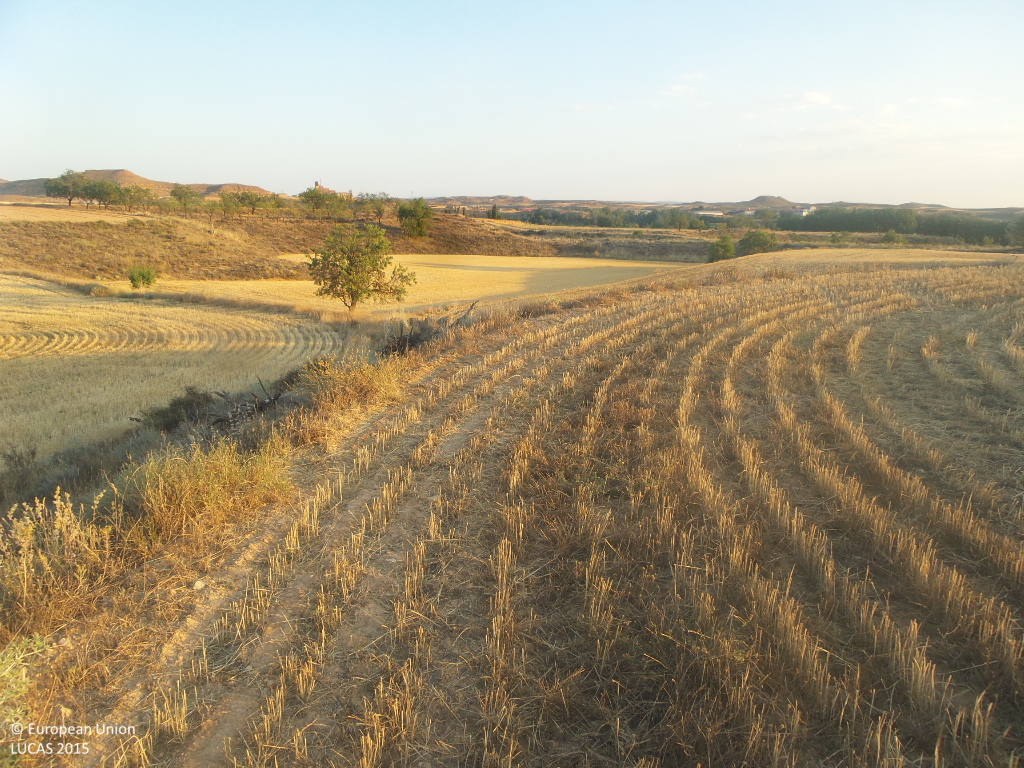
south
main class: Cropland
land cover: Barley
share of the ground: < 10 %
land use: Agriculture (excluding fallow land and kitchen gardens)
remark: Harvested field
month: July
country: ES
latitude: 41.3048
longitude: -2.1043
